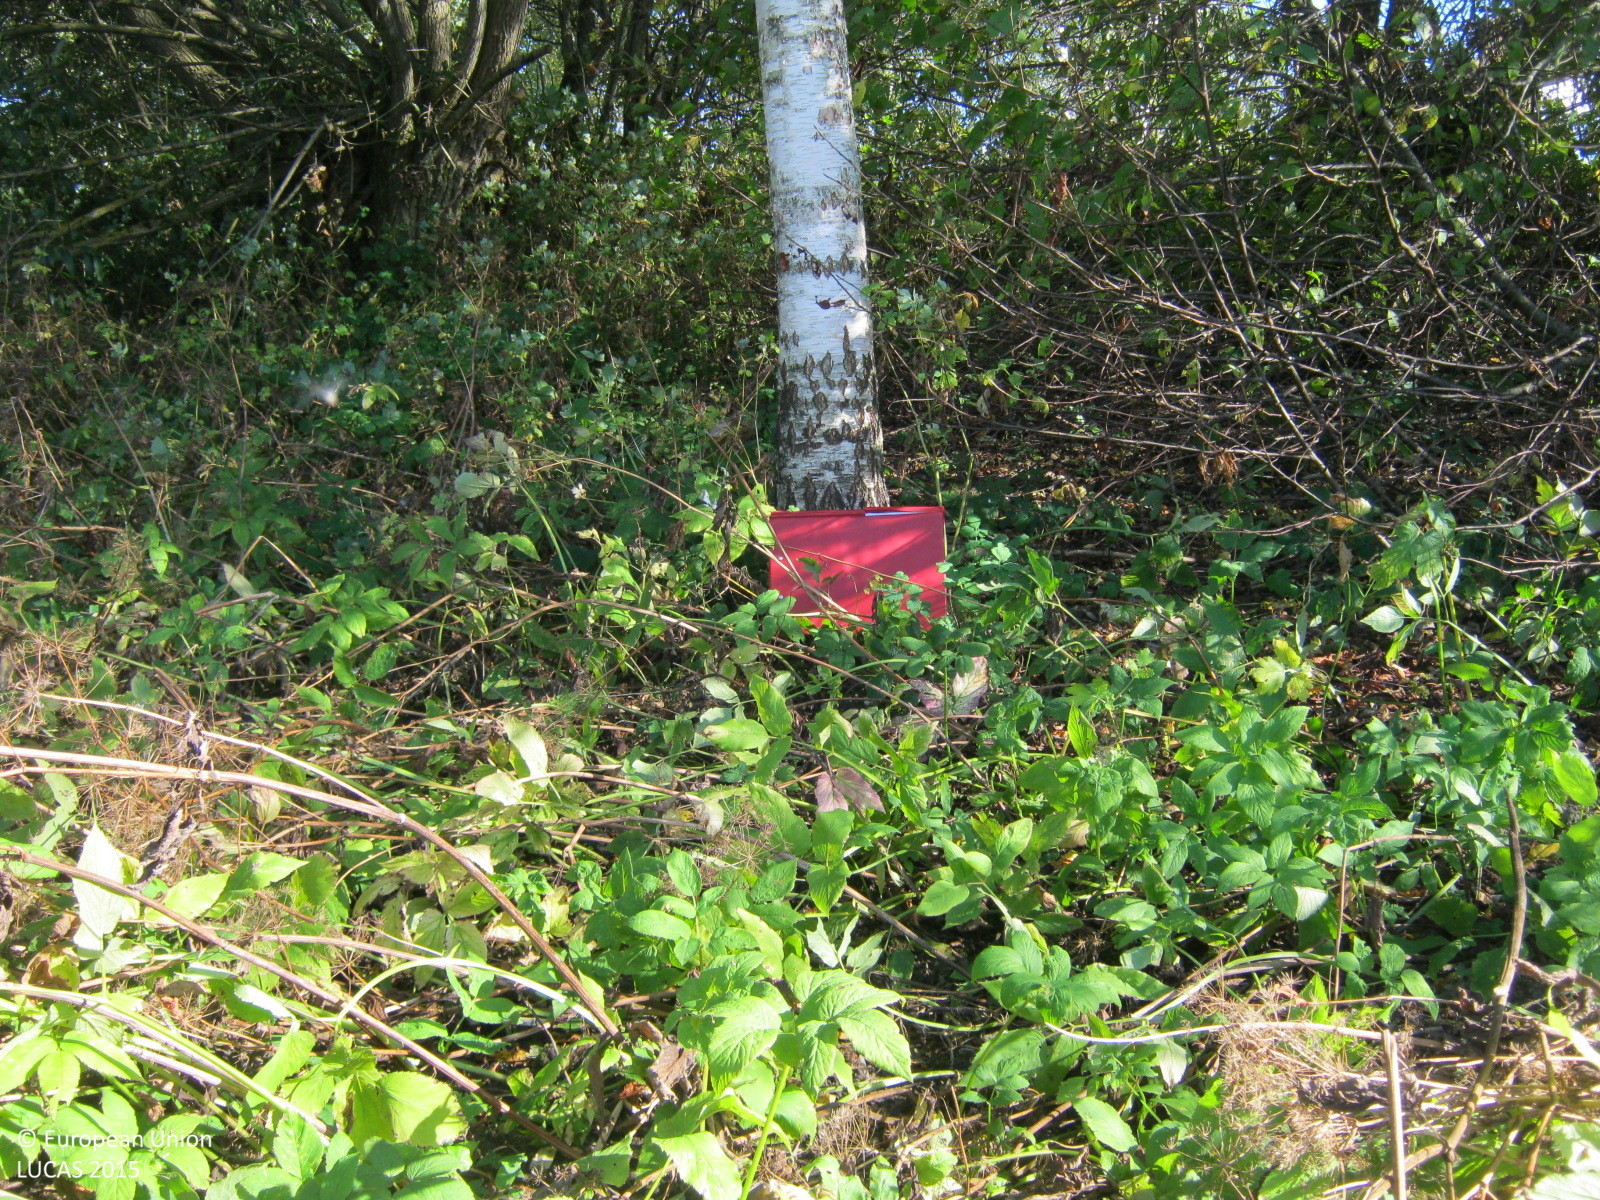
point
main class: Woodland
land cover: Broadleaved woodland
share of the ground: > 75 %
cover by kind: broadleaved forest trees 90 %, herbaceous plants 10 %
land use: Semi-natural and natural areas not in use
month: September
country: LV
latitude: 57.2828
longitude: 24.6438
